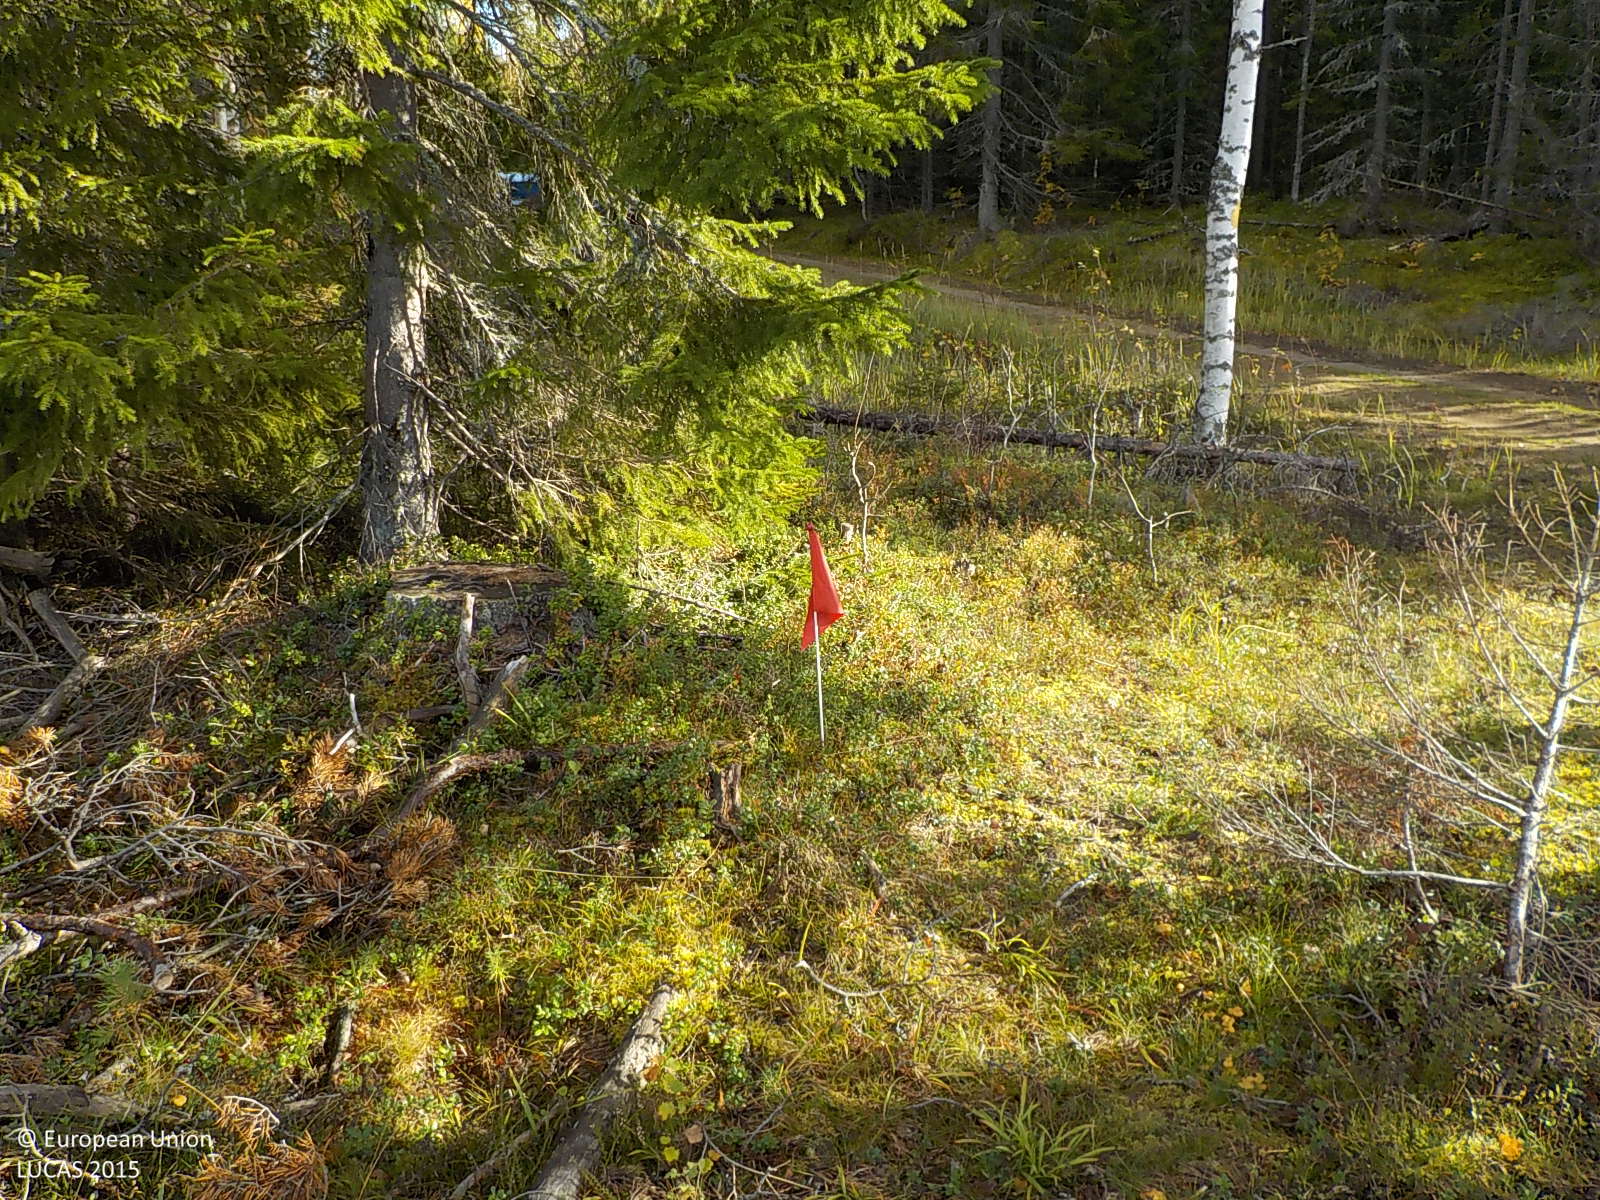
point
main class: Woodland
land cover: Spruce dominated mixed woodland
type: boreal forest
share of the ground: 50 - 75 %
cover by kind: coniferous forest trees 40 %, shrubs 35 %, broadleaved forest trees 20 %, consolidated bare surface 5 %
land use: Forestry
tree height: > 5 m
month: October
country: SE
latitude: 62.9721
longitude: 18.4811
